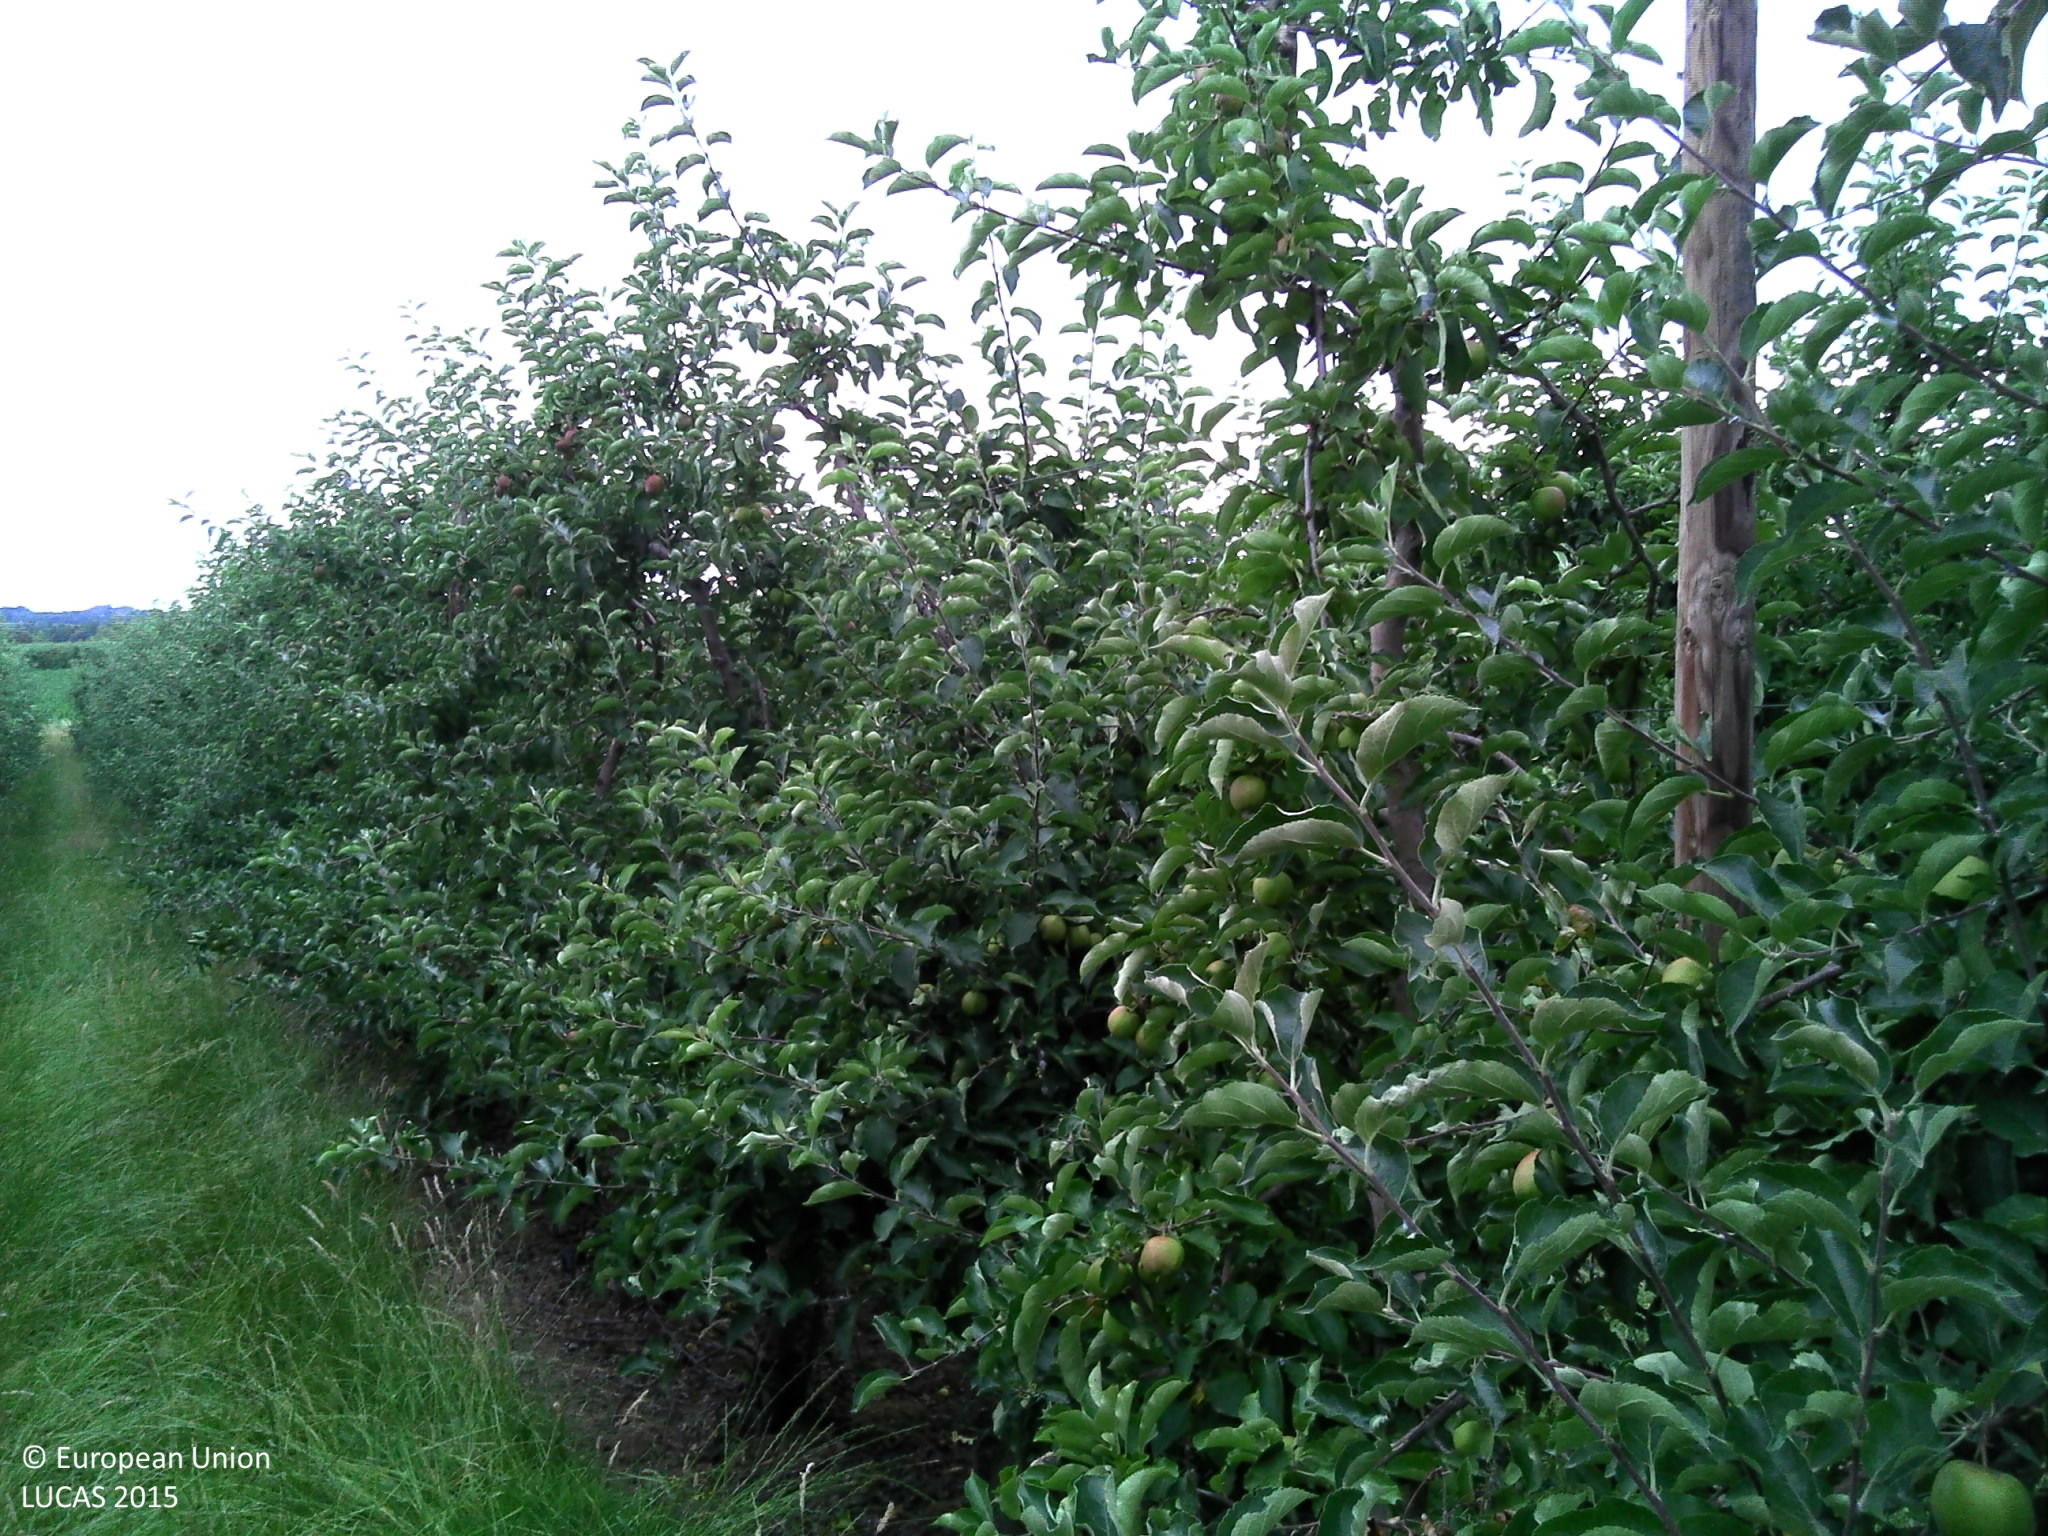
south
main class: Cropland
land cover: Apple fruit
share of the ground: 50 - 75 %
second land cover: Grassland without tree/shrub cover
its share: 25 - 50 %
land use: Agriculture (excluding fallow land and kitchen gardens)
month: July
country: BE
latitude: 50.9048
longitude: 5.0342
